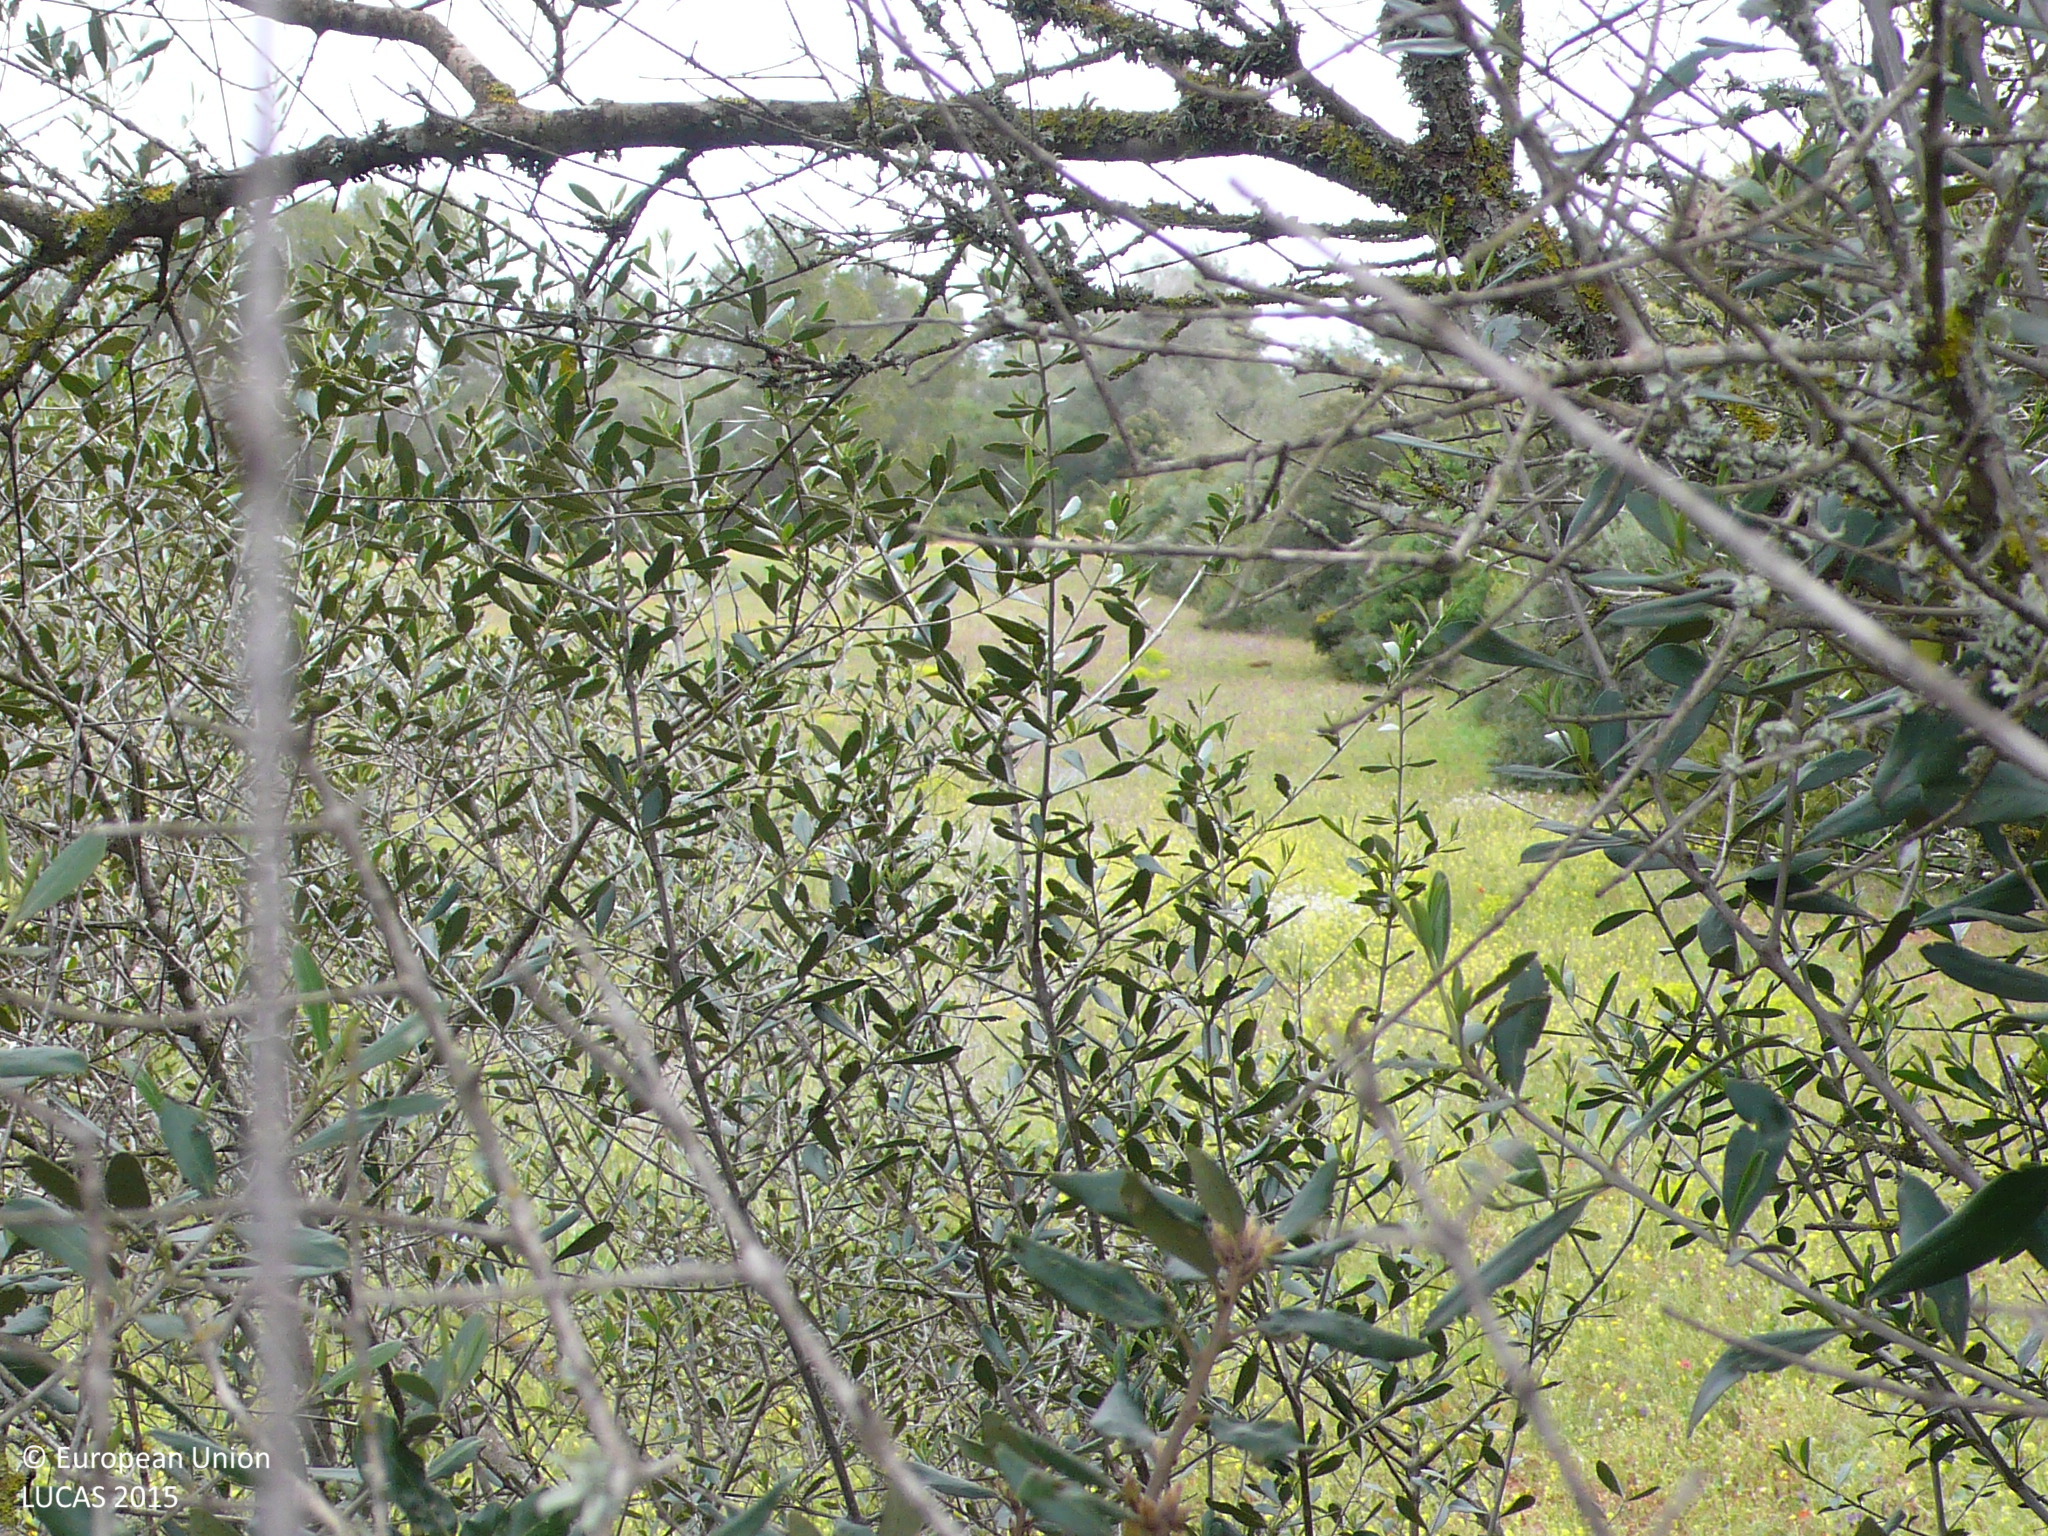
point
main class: Grassland
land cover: Spontaneously vegetated surfaces
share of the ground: > 75 %
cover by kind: herbaceous plants 100 %
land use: Fallow land
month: April
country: ES
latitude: 39.6095
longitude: 2.8903
